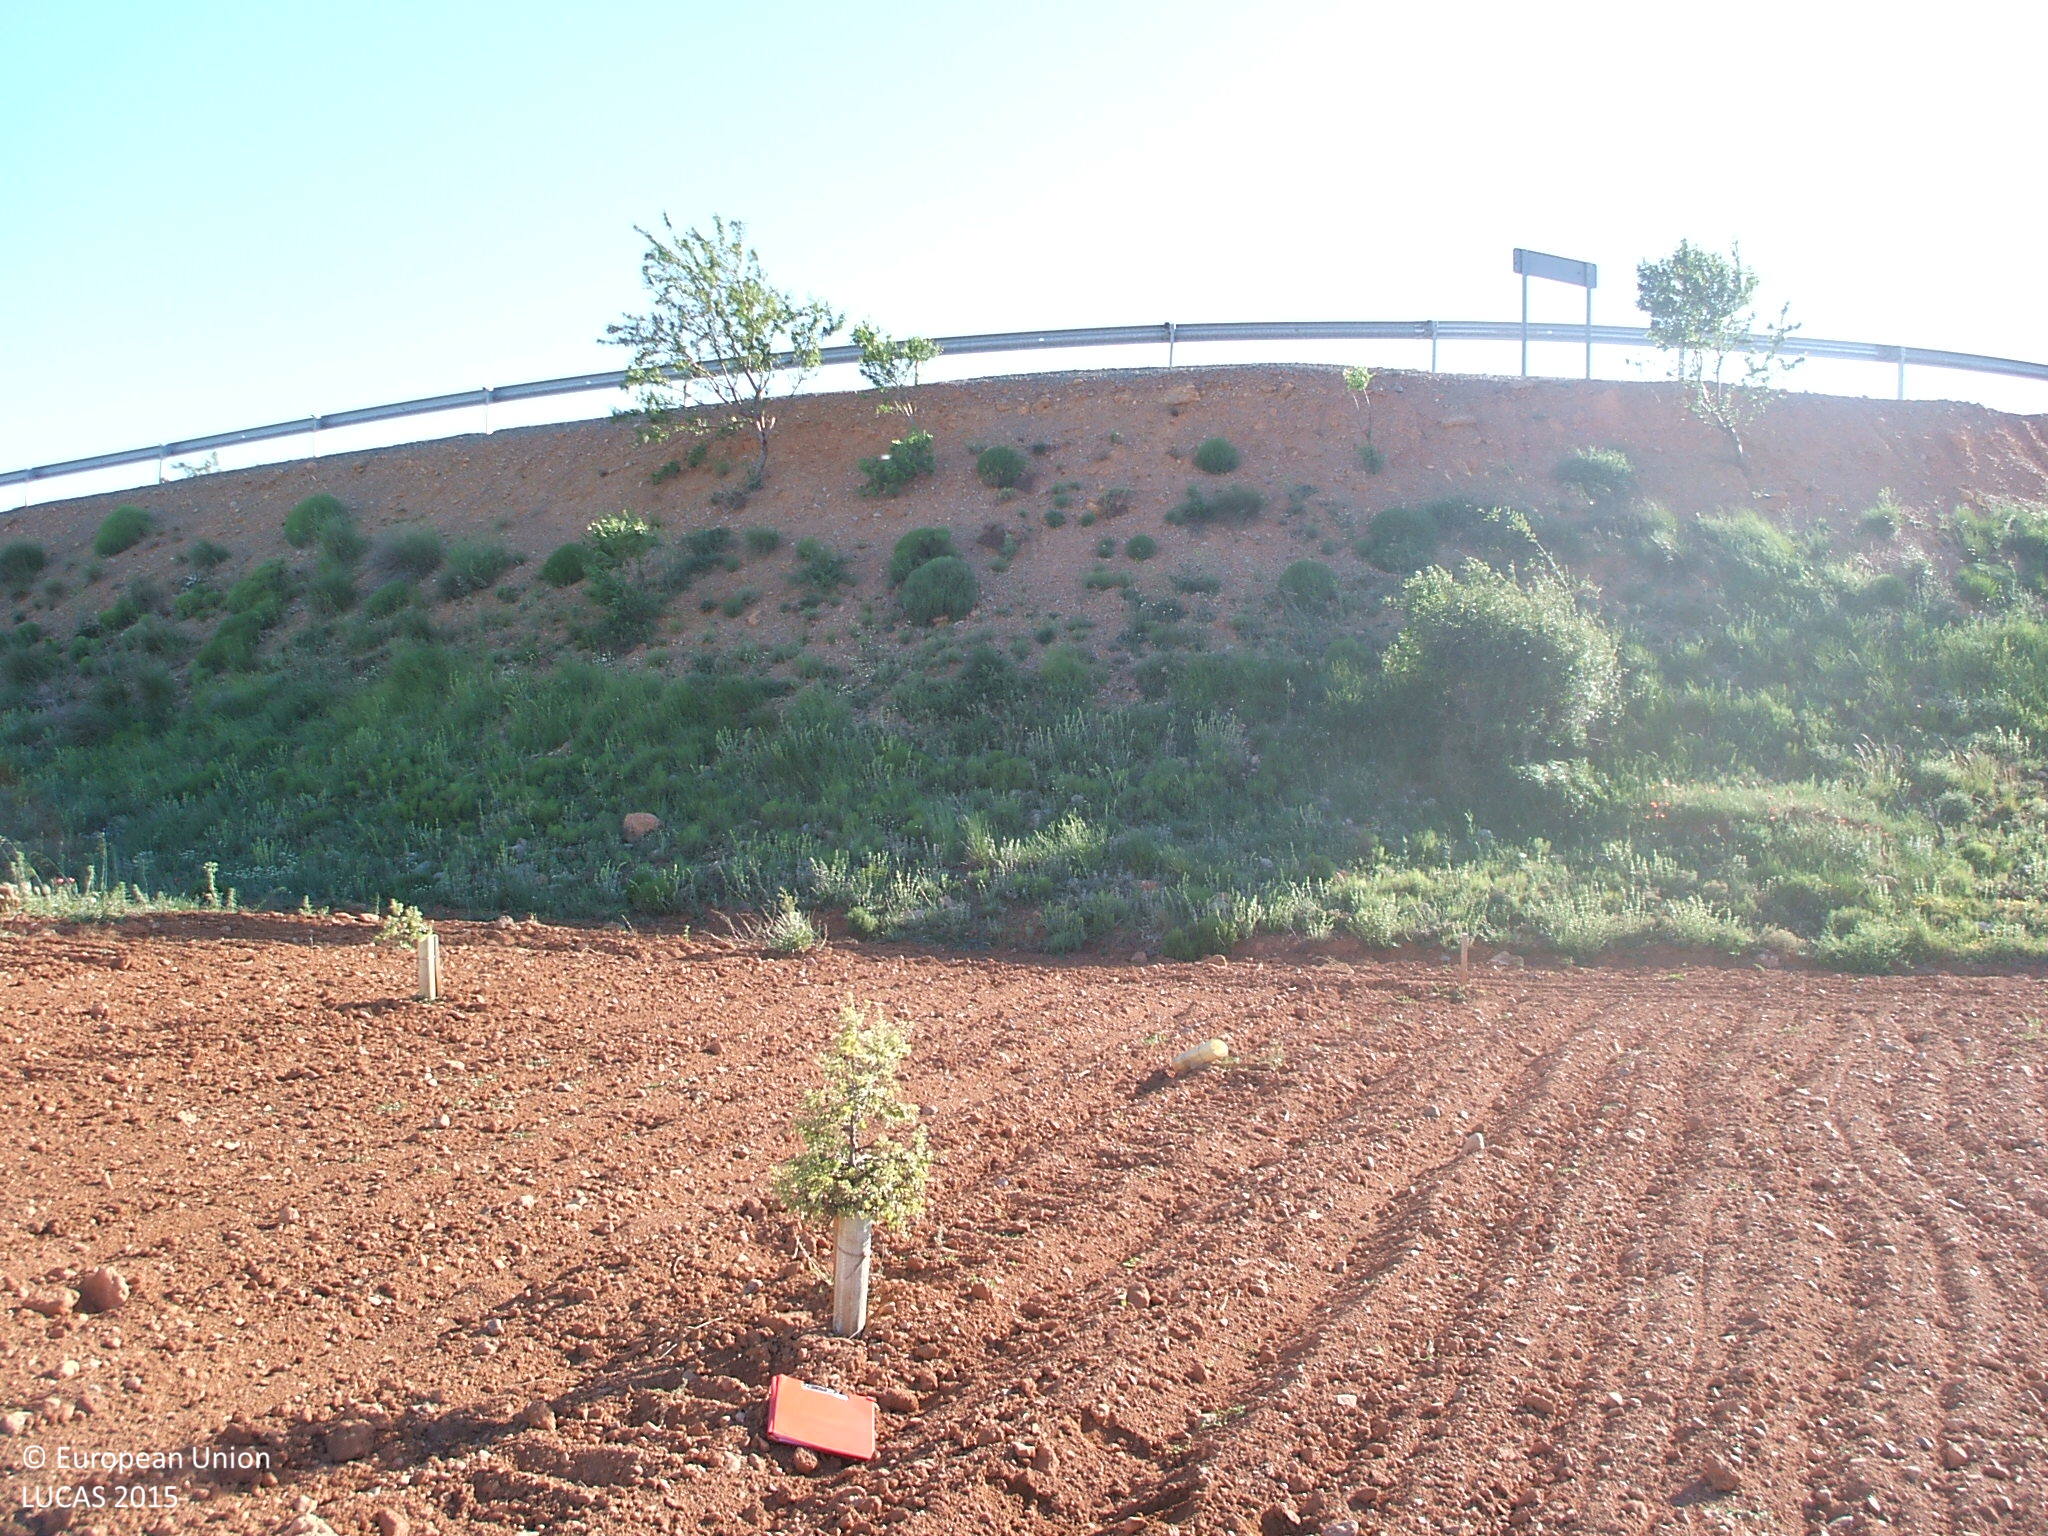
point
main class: Woodland
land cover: Broadleaved woodland
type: broadleaved evergreen forest
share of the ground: 10 - 25 %
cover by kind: unconsolidated bare surface 85 %, broadleaved forest trees 15 %
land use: Forestry
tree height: < 5 m
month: May
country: ES
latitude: 40.1136
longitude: -0.7413
